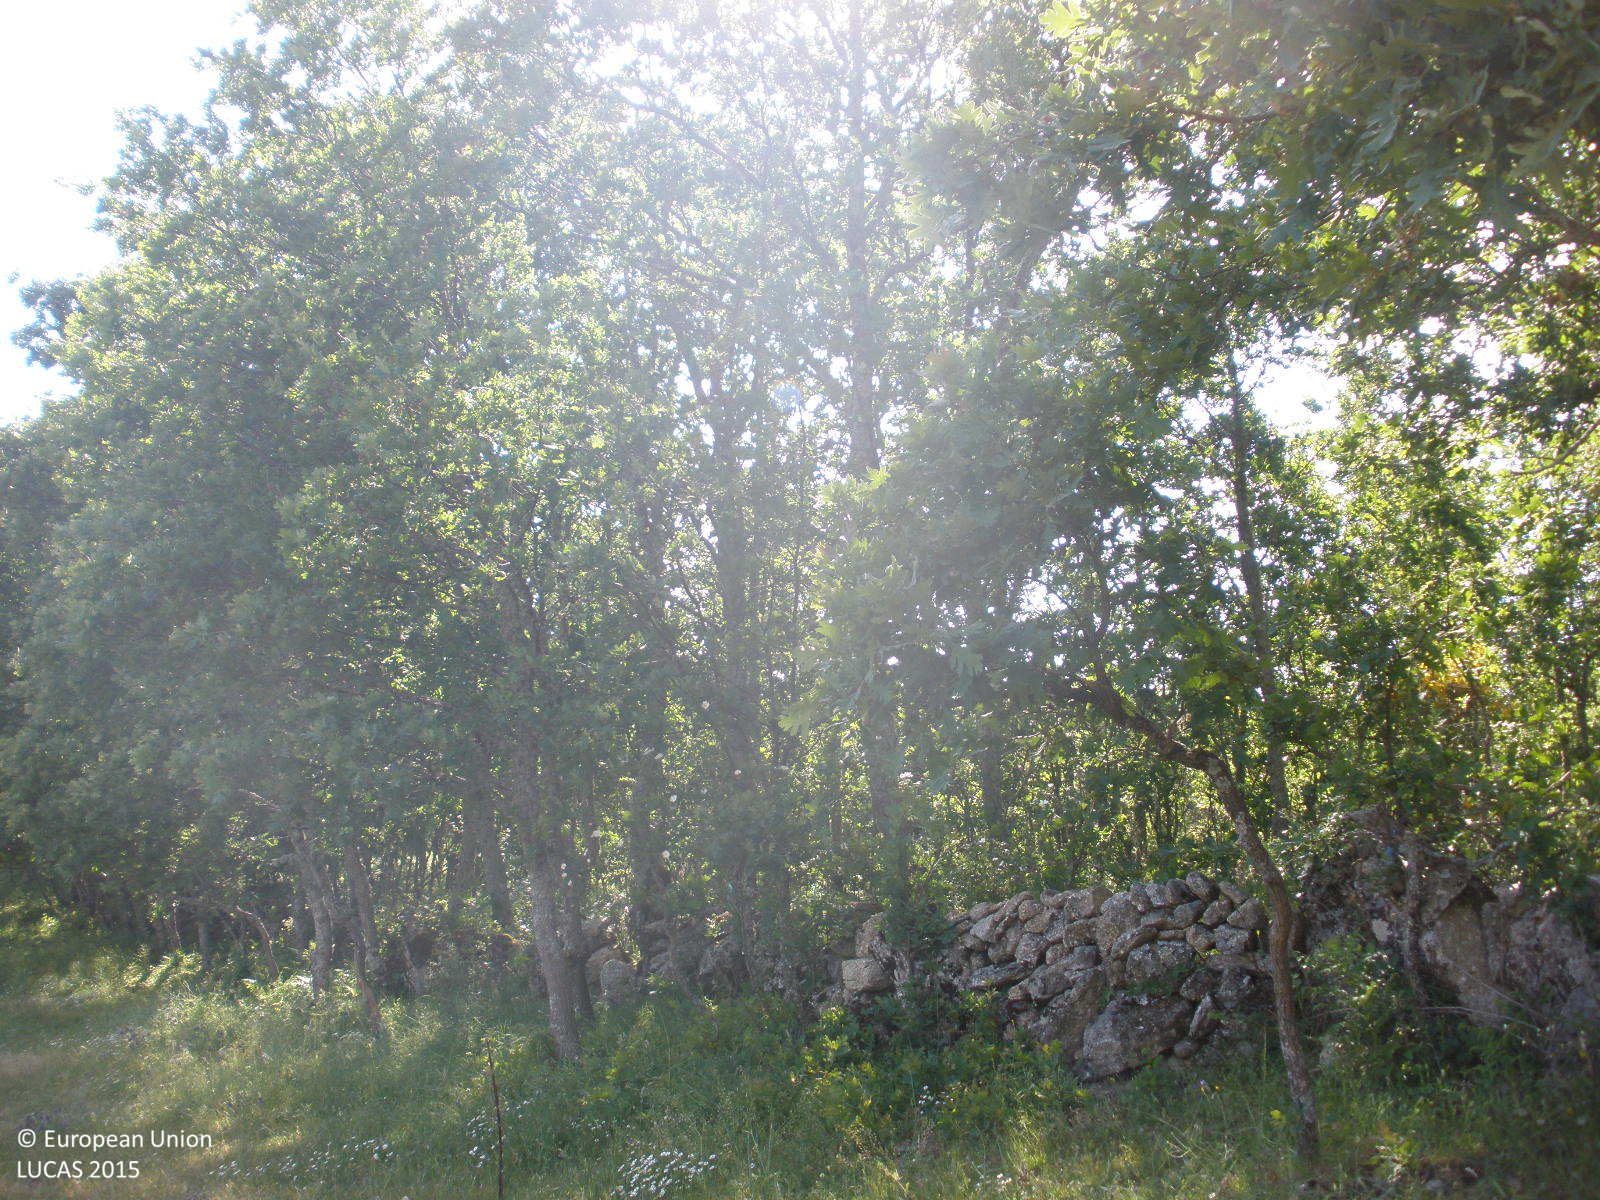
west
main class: Grassland
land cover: Grassland without tree/shrub cover
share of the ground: > 75 %
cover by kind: herbaceous plants 100 %
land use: Agriculture (excluding fallow land and kitchen gardens)
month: May
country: ES
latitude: 40.3753
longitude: -5.9148
